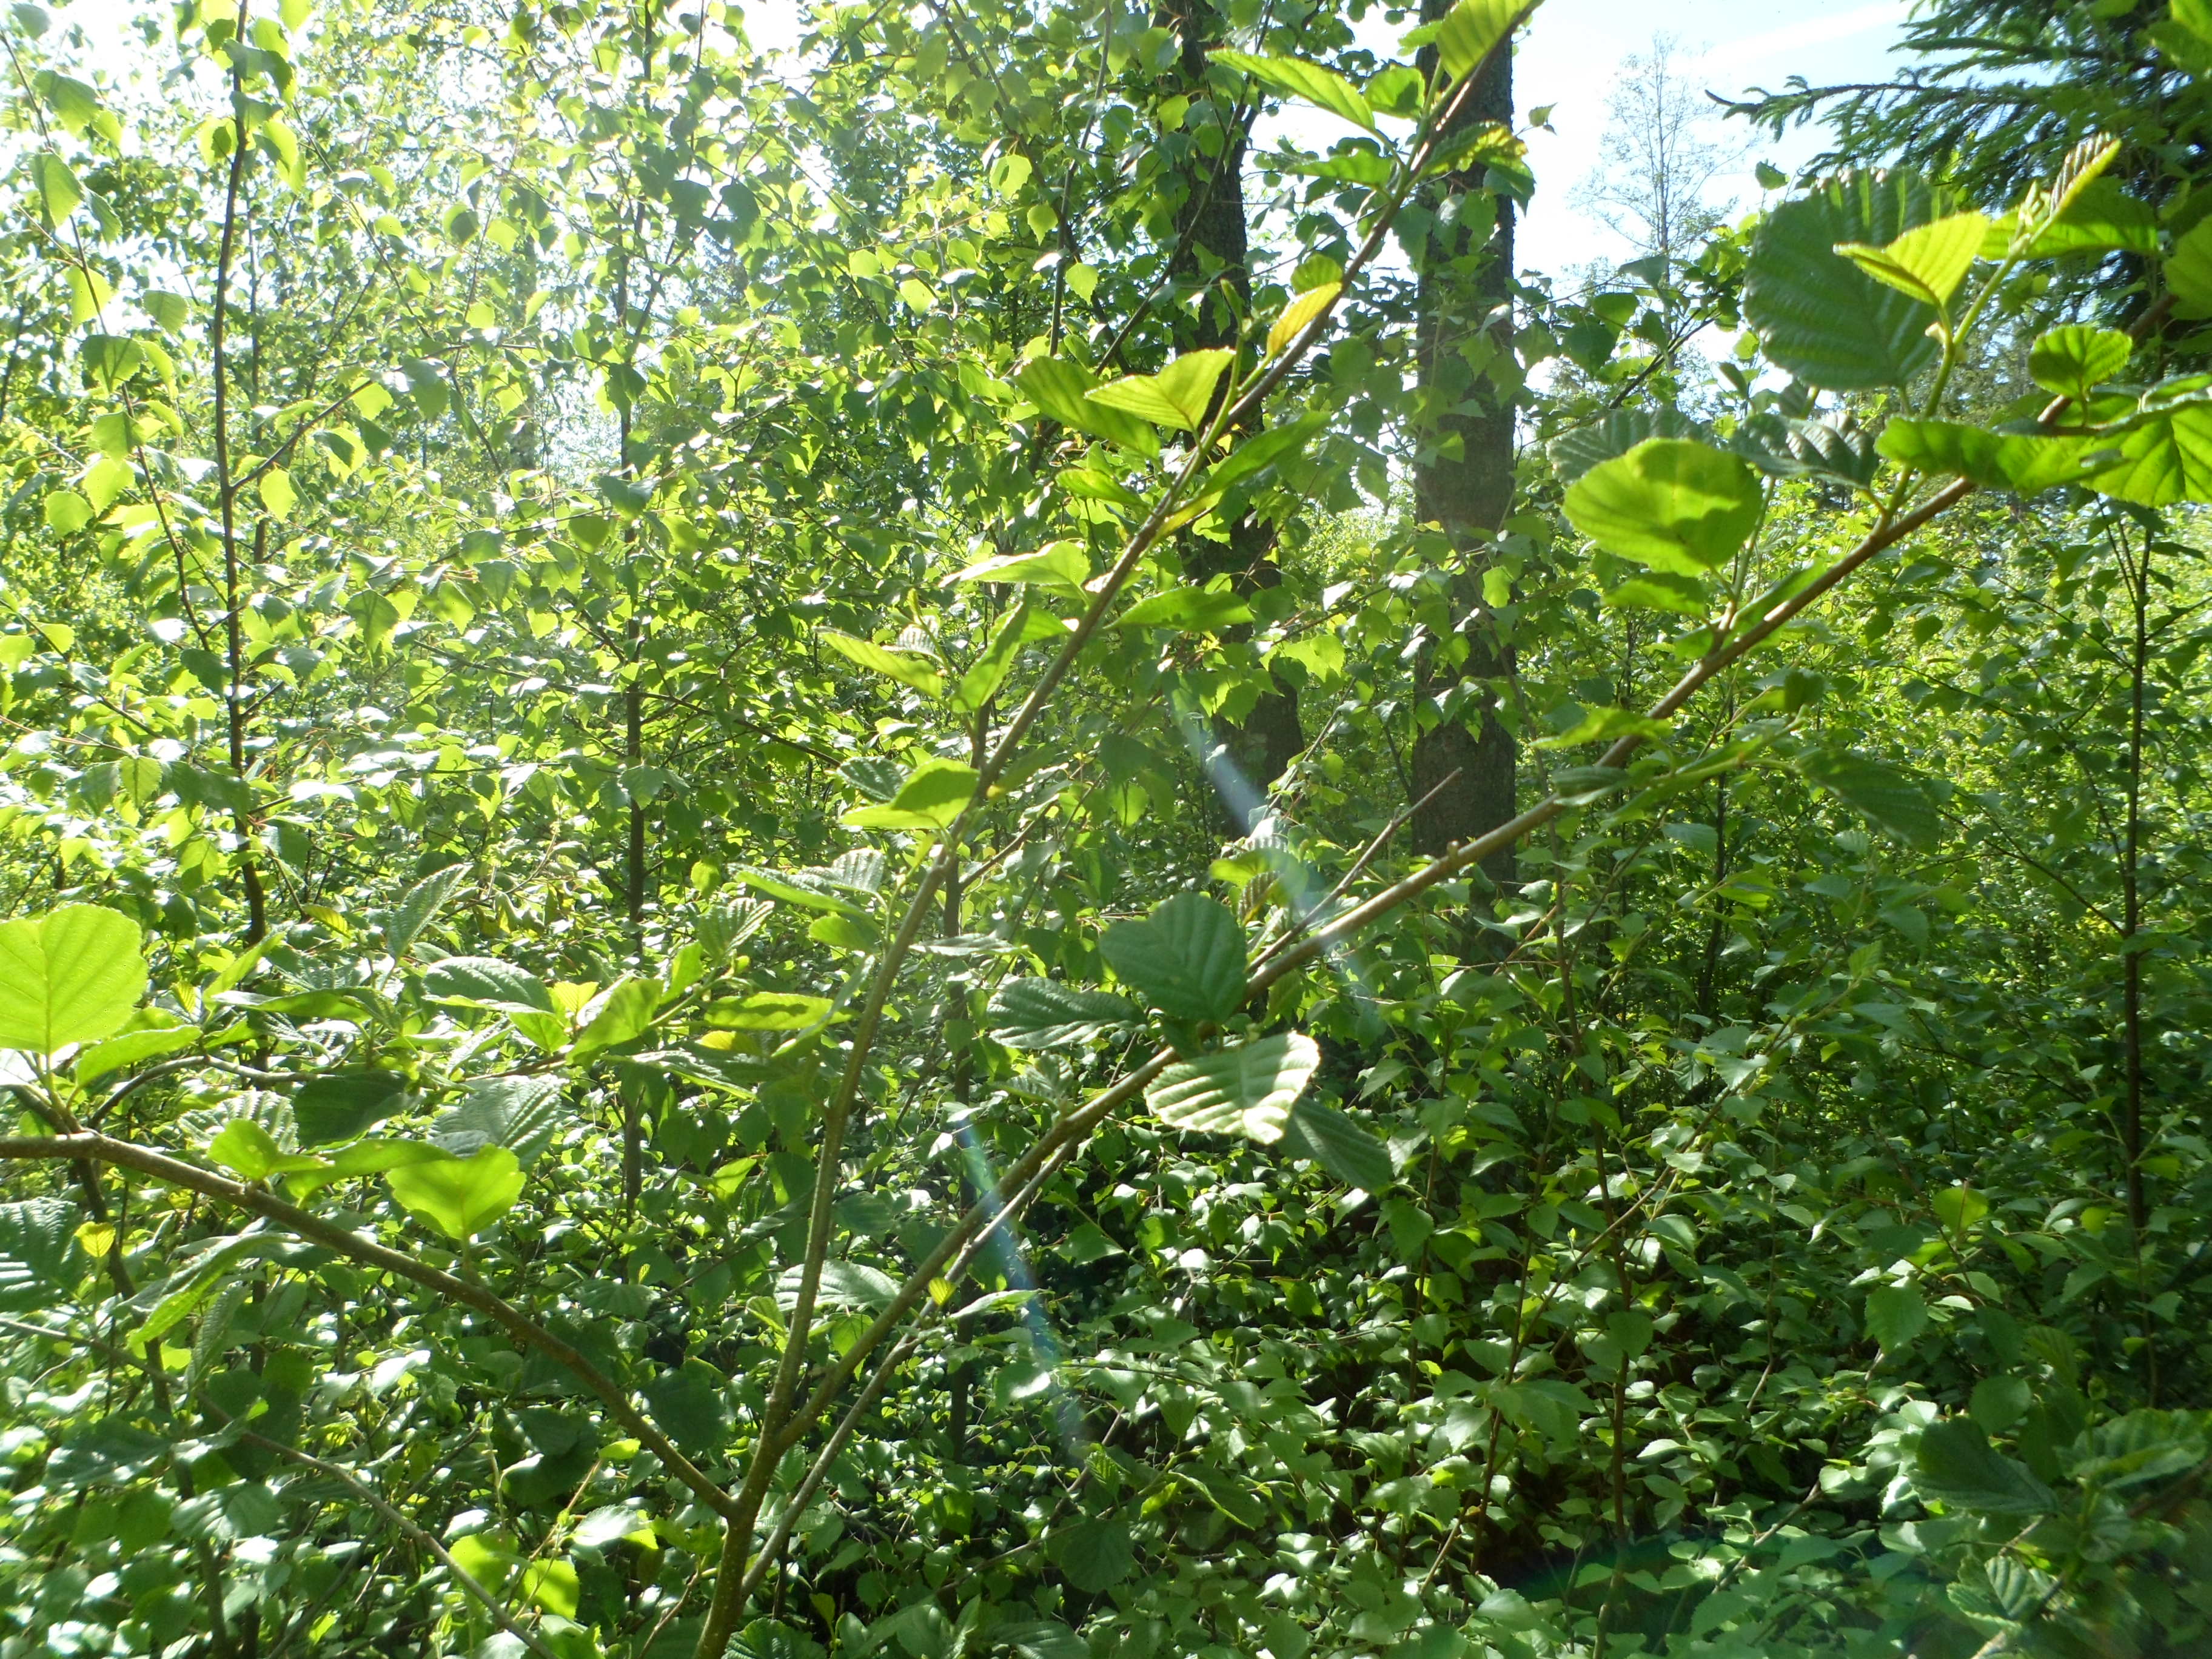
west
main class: Woodland
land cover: Broadleaved woodland
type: boreal forest
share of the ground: > 75 %
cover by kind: broadleaved forest trees 90 %, herbaceous plants 5 %, unconsolidated bare surface 5 %
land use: Forestry
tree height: < 5 m
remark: Clear cut
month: June
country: SE
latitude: 56.9955
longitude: 14.8858
